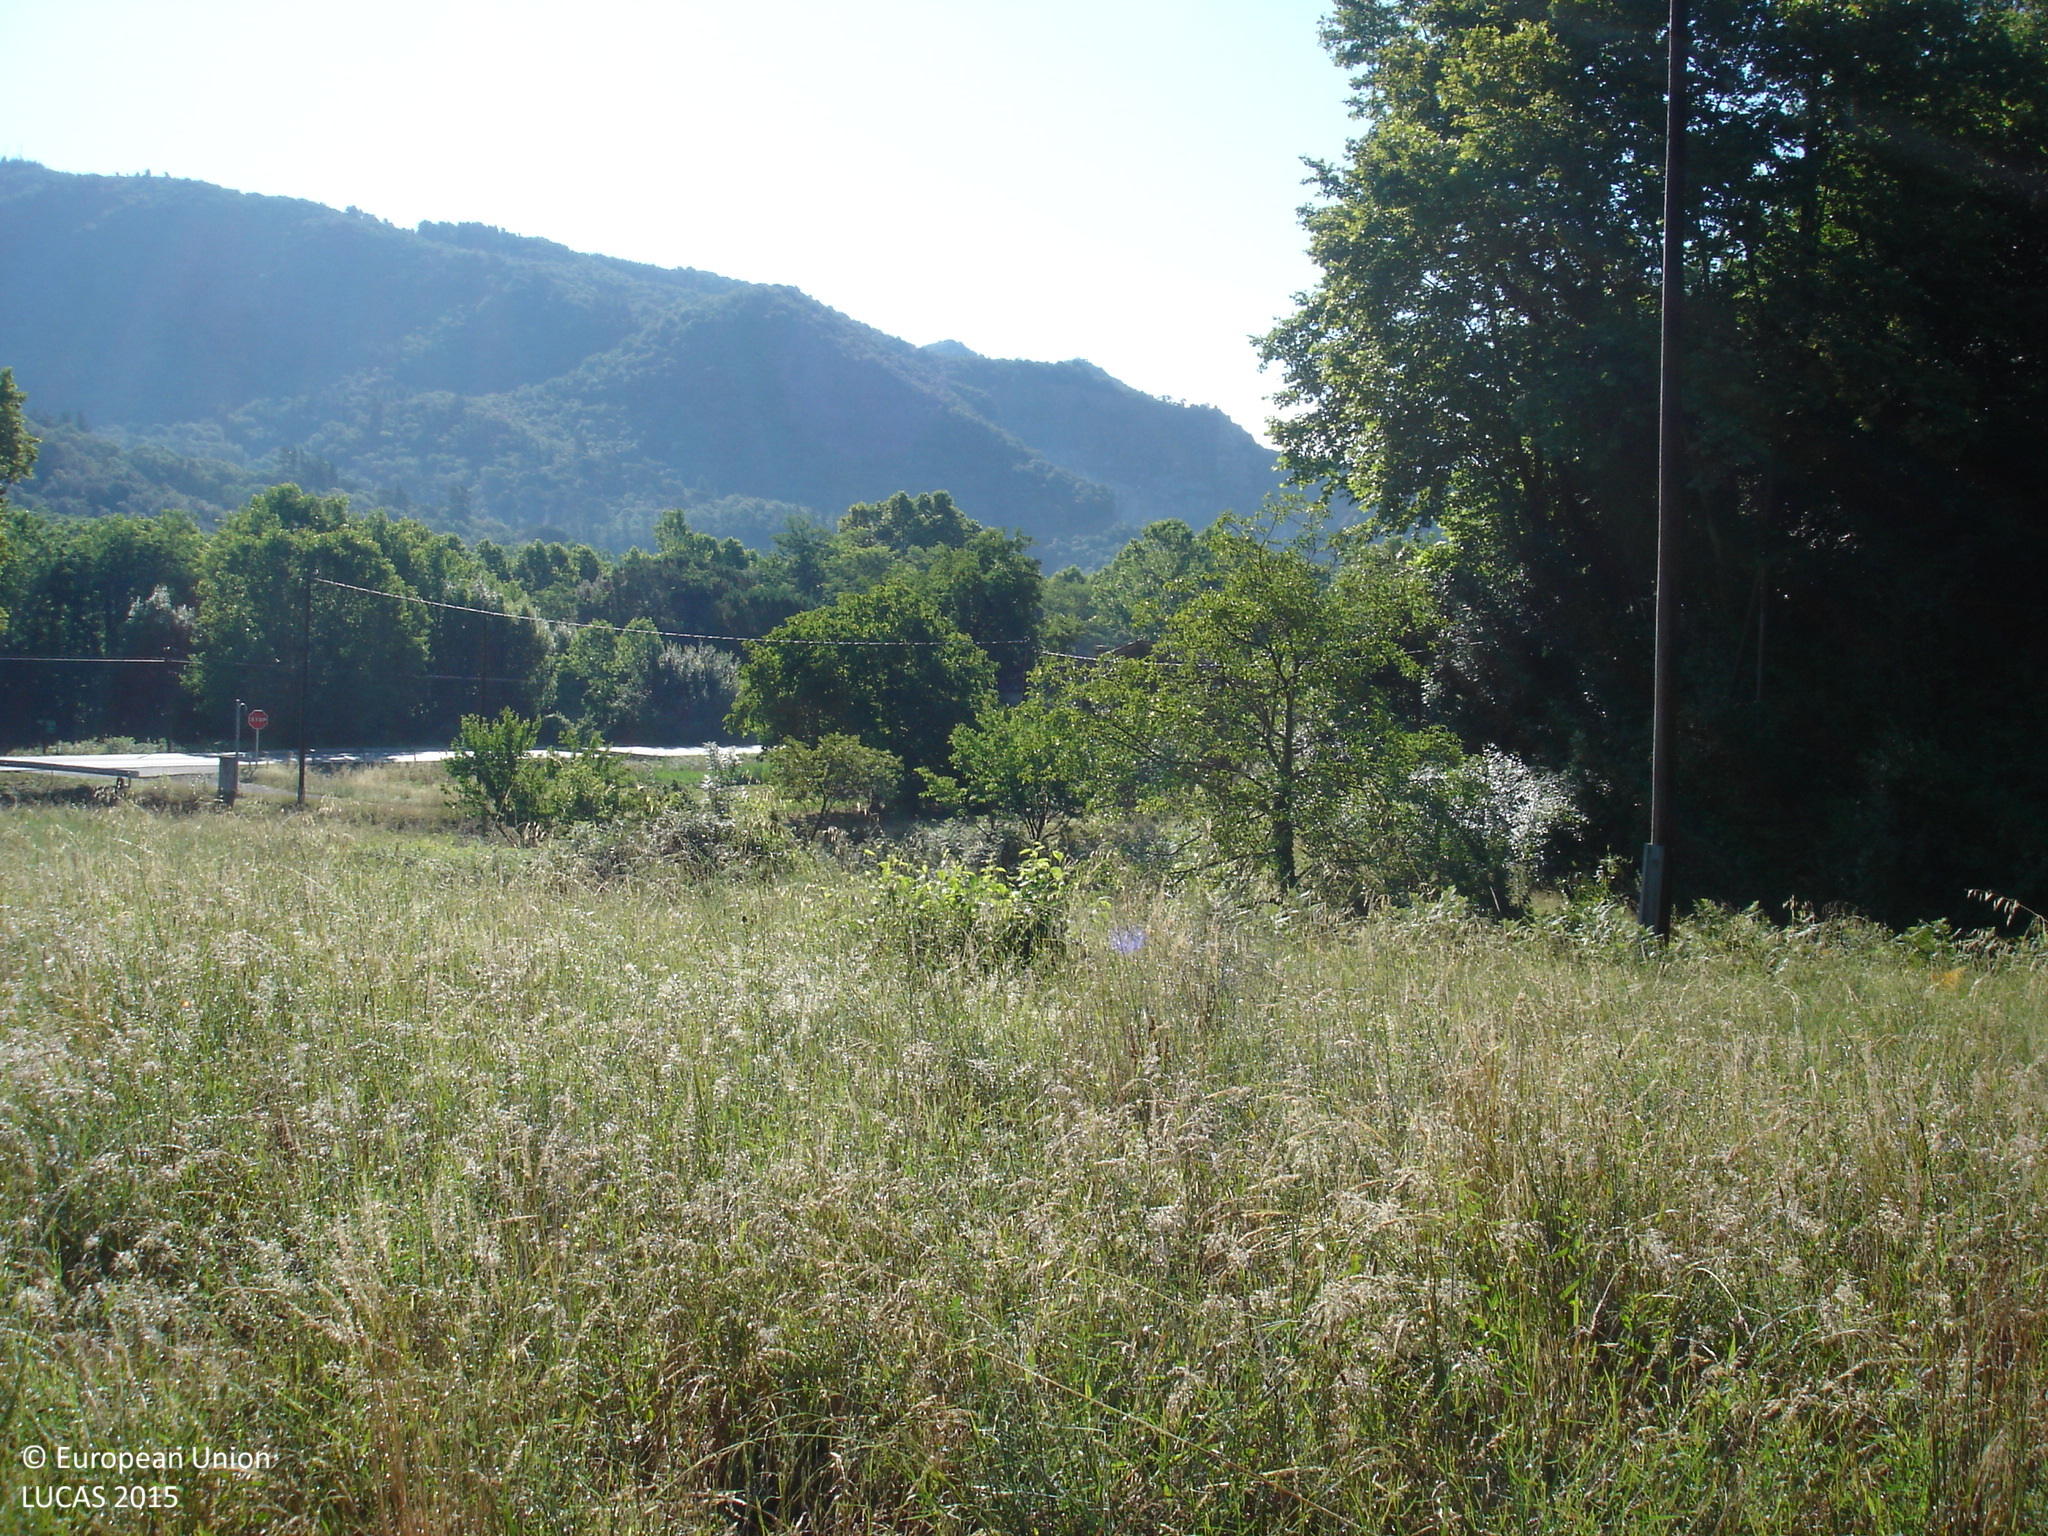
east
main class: Grassland
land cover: Spontaneously vegetated surfaces
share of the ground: > 75 %
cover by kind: herbaceous plants 95 %, shrubs 5 %
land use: Fallow land
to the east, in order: Spontaneously vegetated surfaces; Electric lines; Grassland without tree/shrub cover; Dry stone walls; Grassland without tree/shrub cover; Single bushes/trees; Rivers and streams; Grass margins; Tracks; Electric lines; Groves; Other fresh vegetables; Grass margins; Paved roads, cycling and walking lanes; Grass margins; Electric lines; Other mixed woodland; Rivers and streams
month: June
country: ES
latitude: 41.7985
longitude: 2.5425
